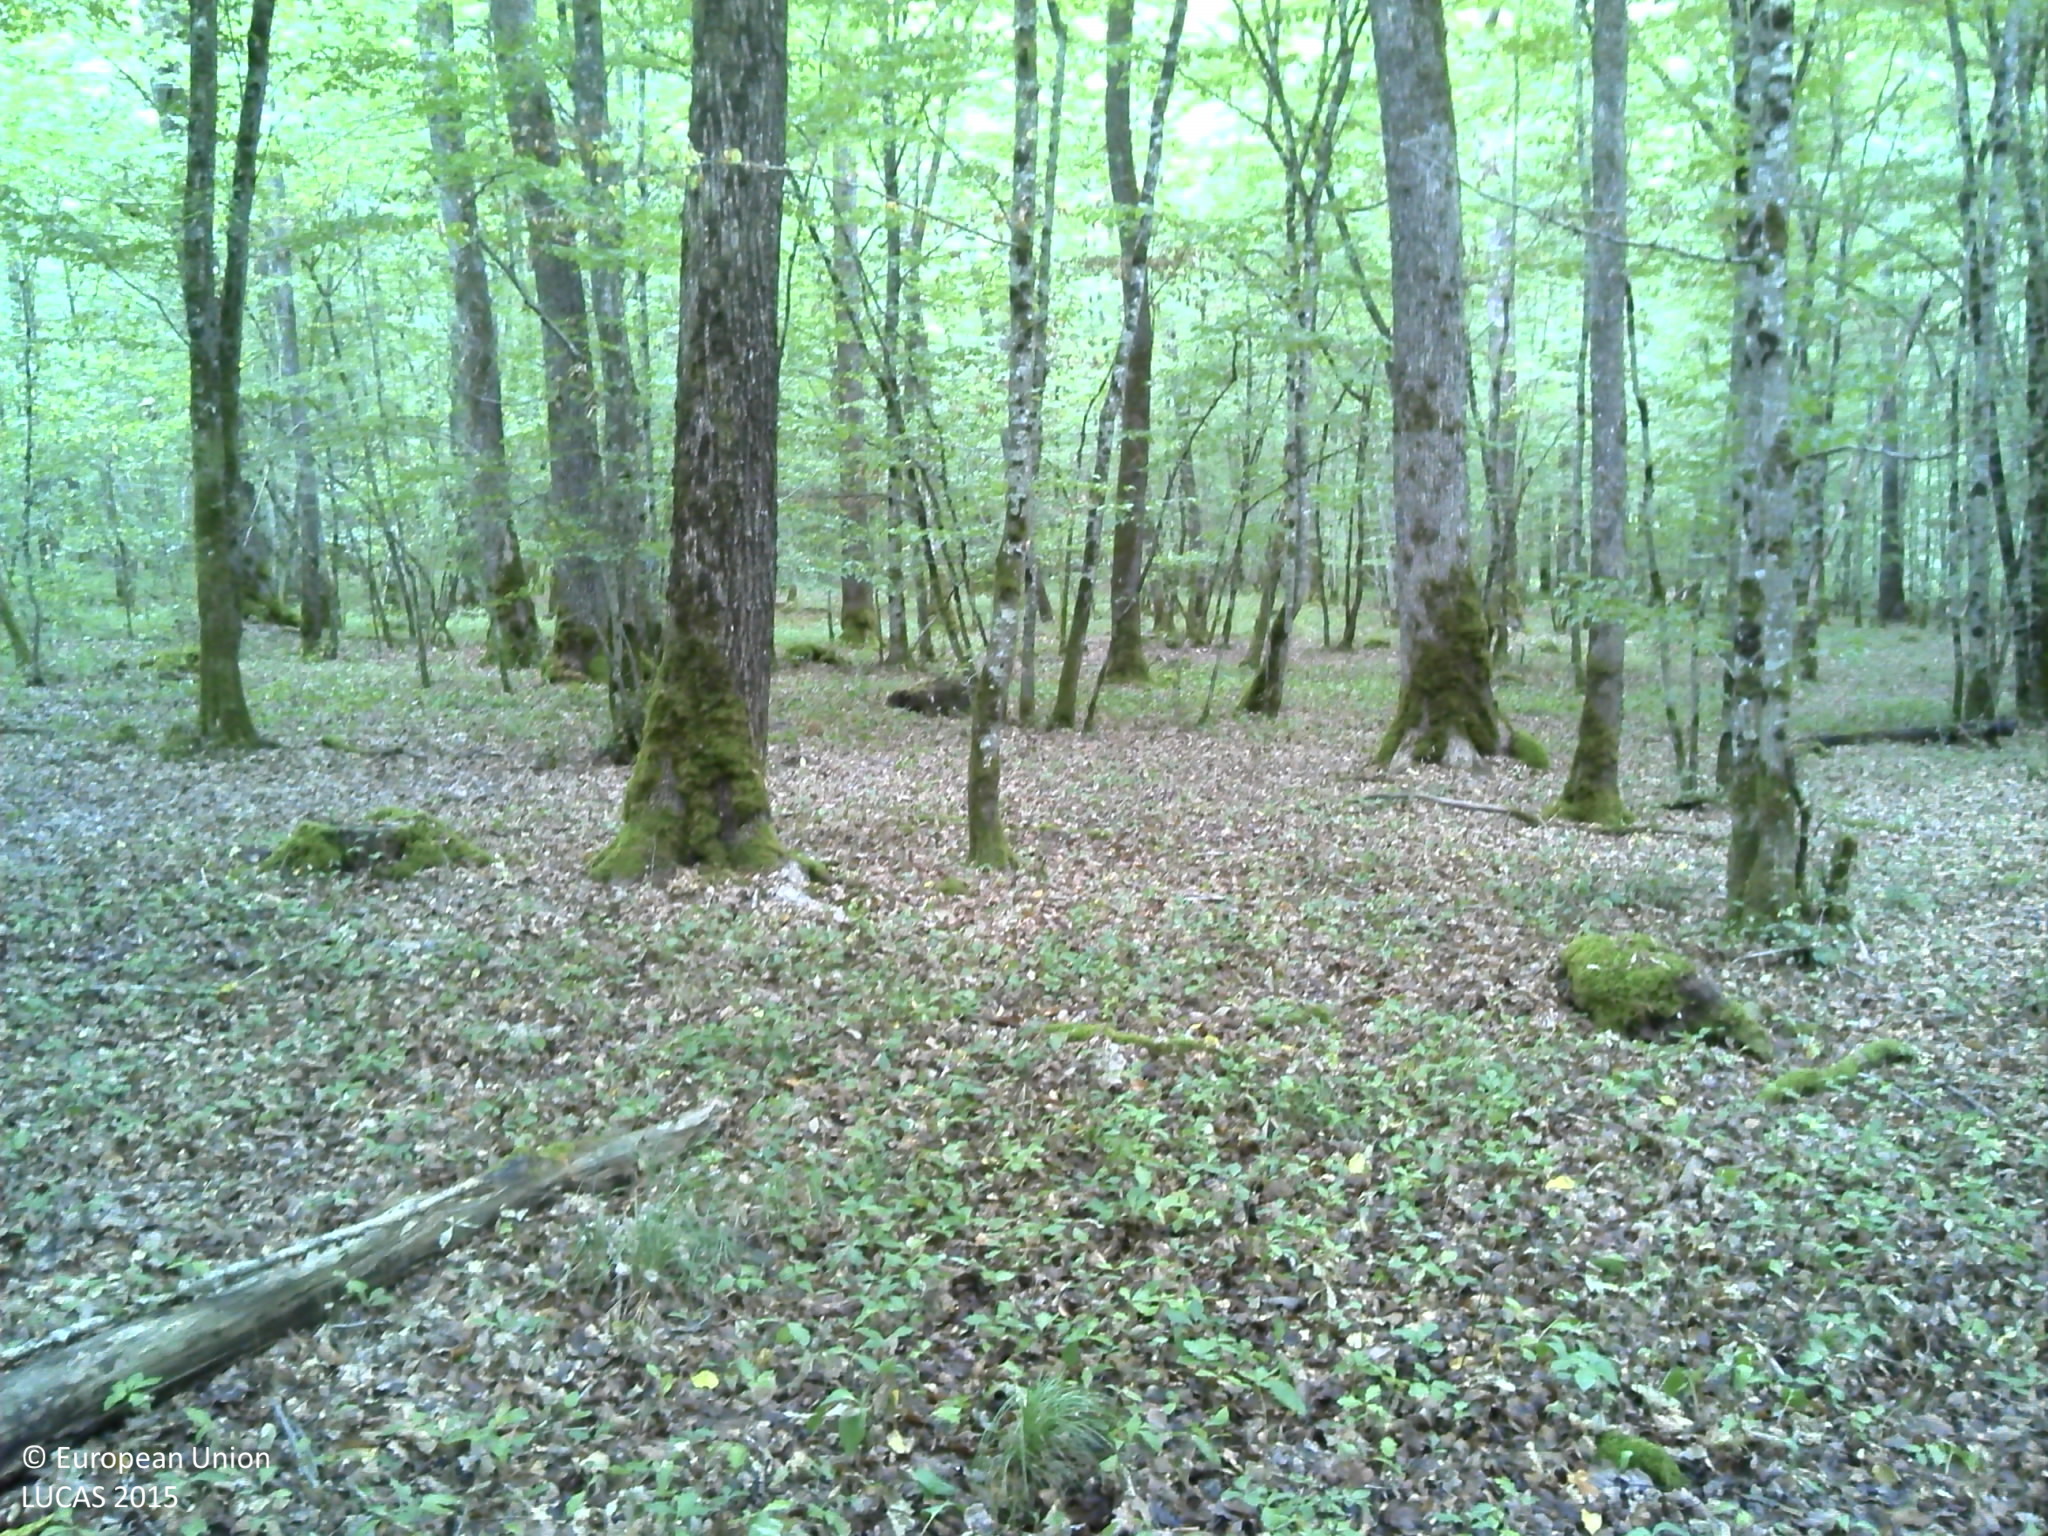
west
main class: Woodland
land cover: Broadleaved woodland
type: beech forest
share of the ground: > 75 %
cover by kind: broadleaved forest trees 95 %, unconsolidated bare surface 5 %
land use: Forestry
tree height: > 5 m
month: August
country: FR
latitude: 48.2298
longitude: 6.1906
